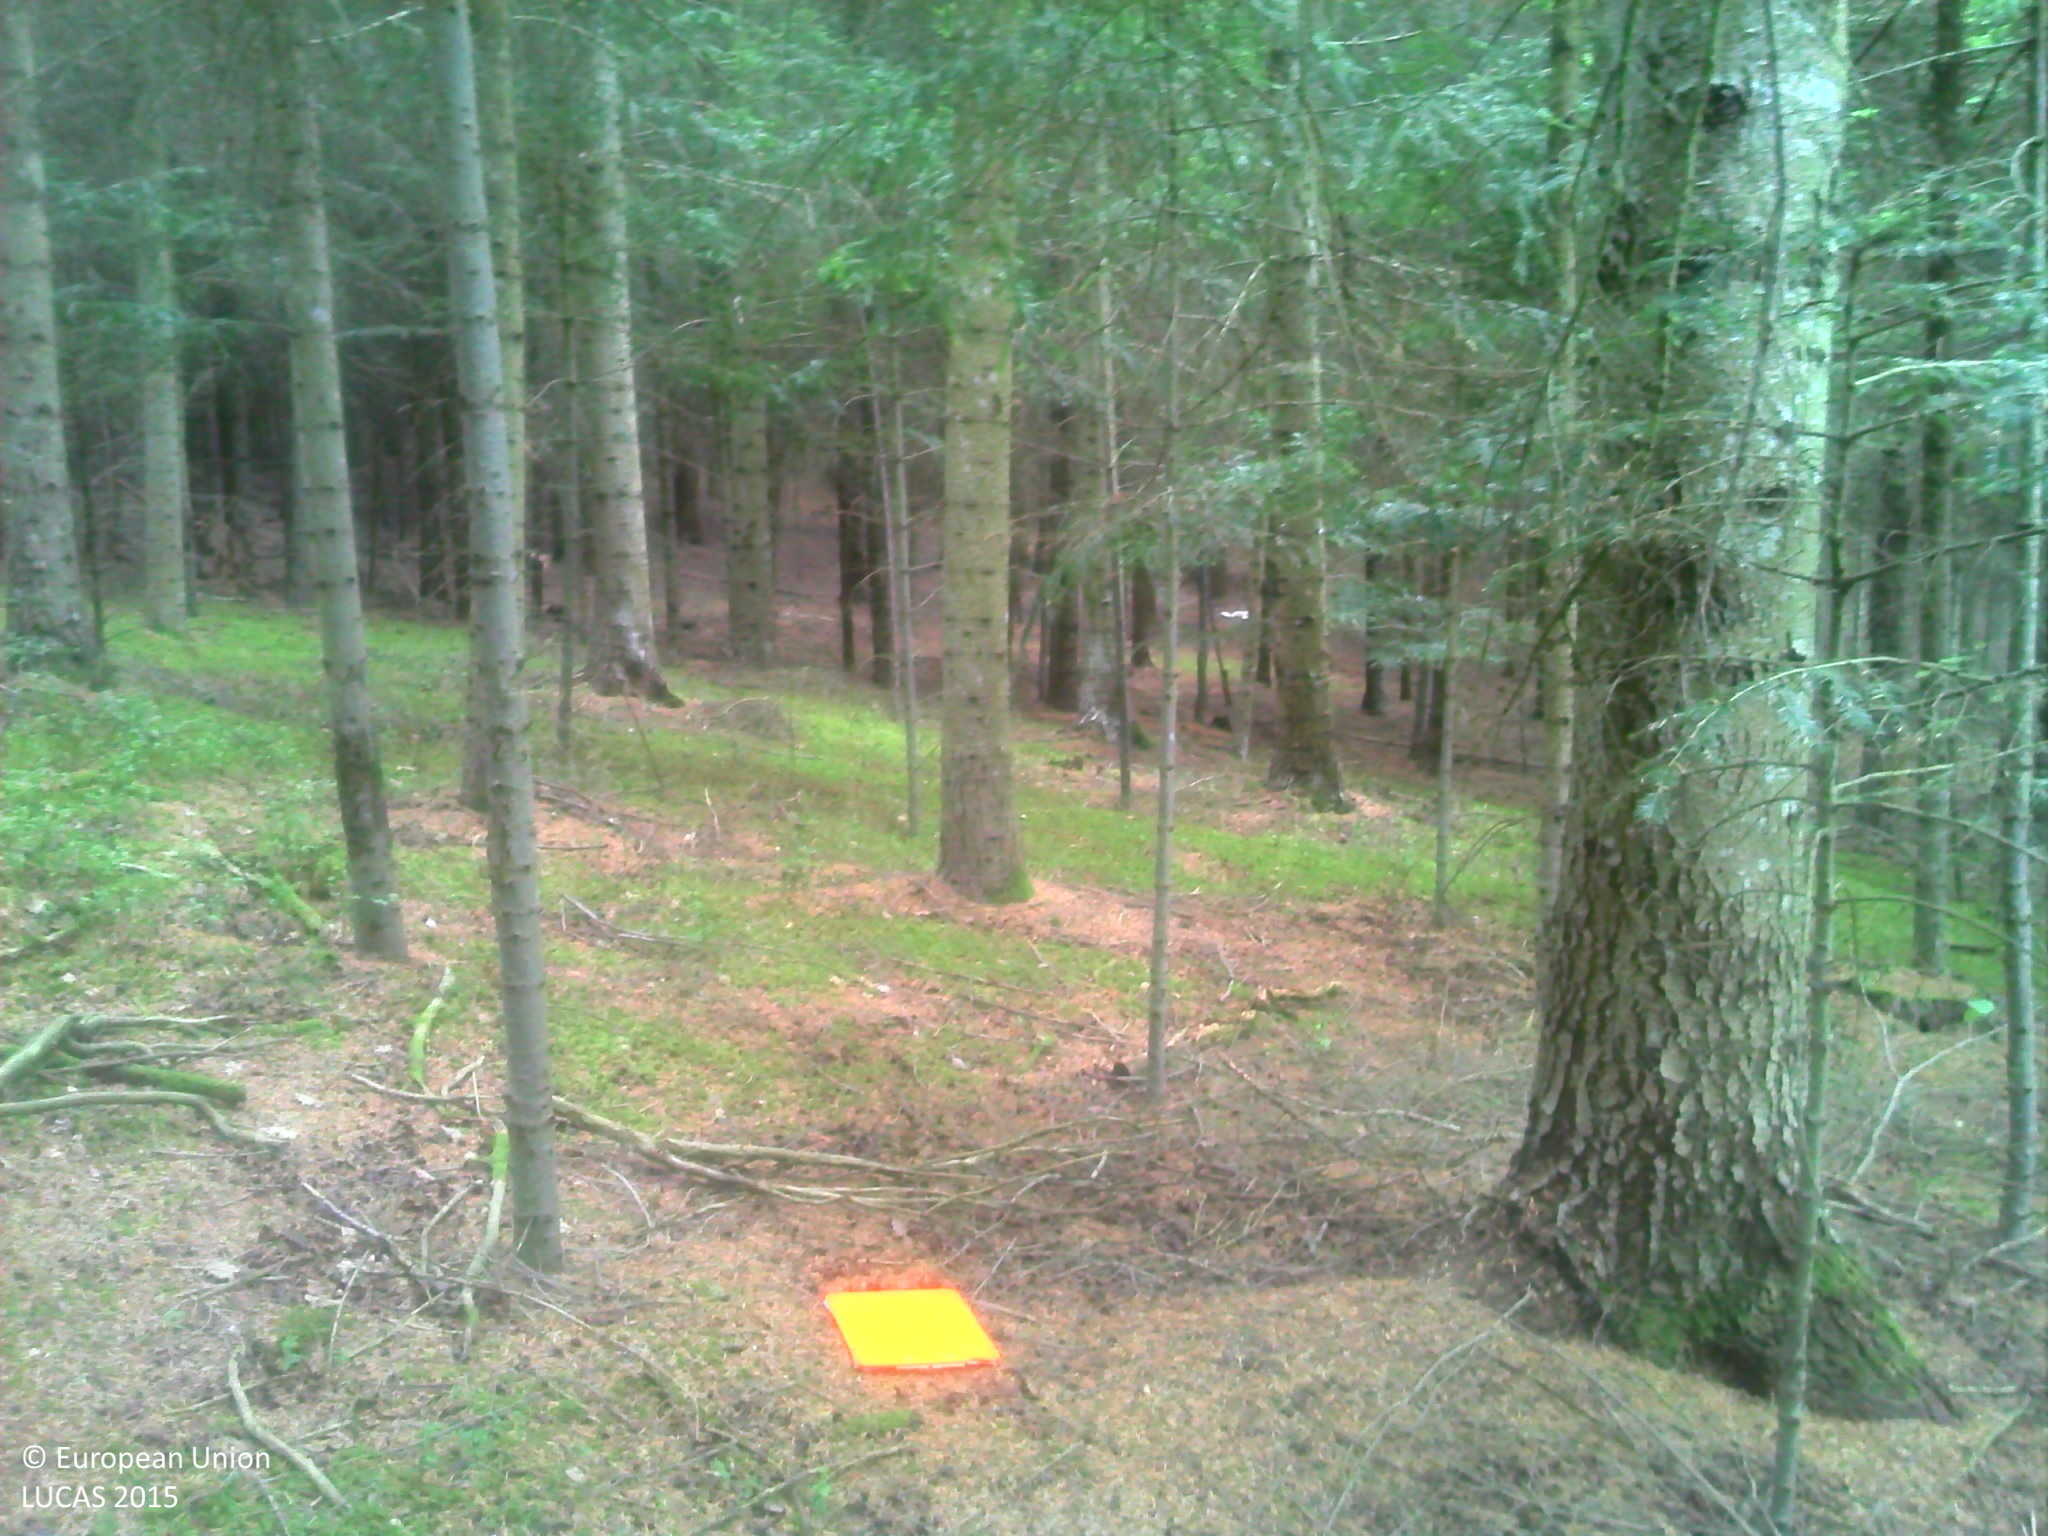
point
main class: Woodland
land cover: Spruce dominated coniferous woodland
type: exotic forest
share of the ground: > 75 %
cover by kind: coniferous forest trees 80 %, lichens and mosses 10 %, herbaceous plants 5 %, unconsolidated bare surface 5 %
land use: Forestry
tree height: > 5 m
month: July
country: FR
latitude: 45.1630
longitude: 3.8590
